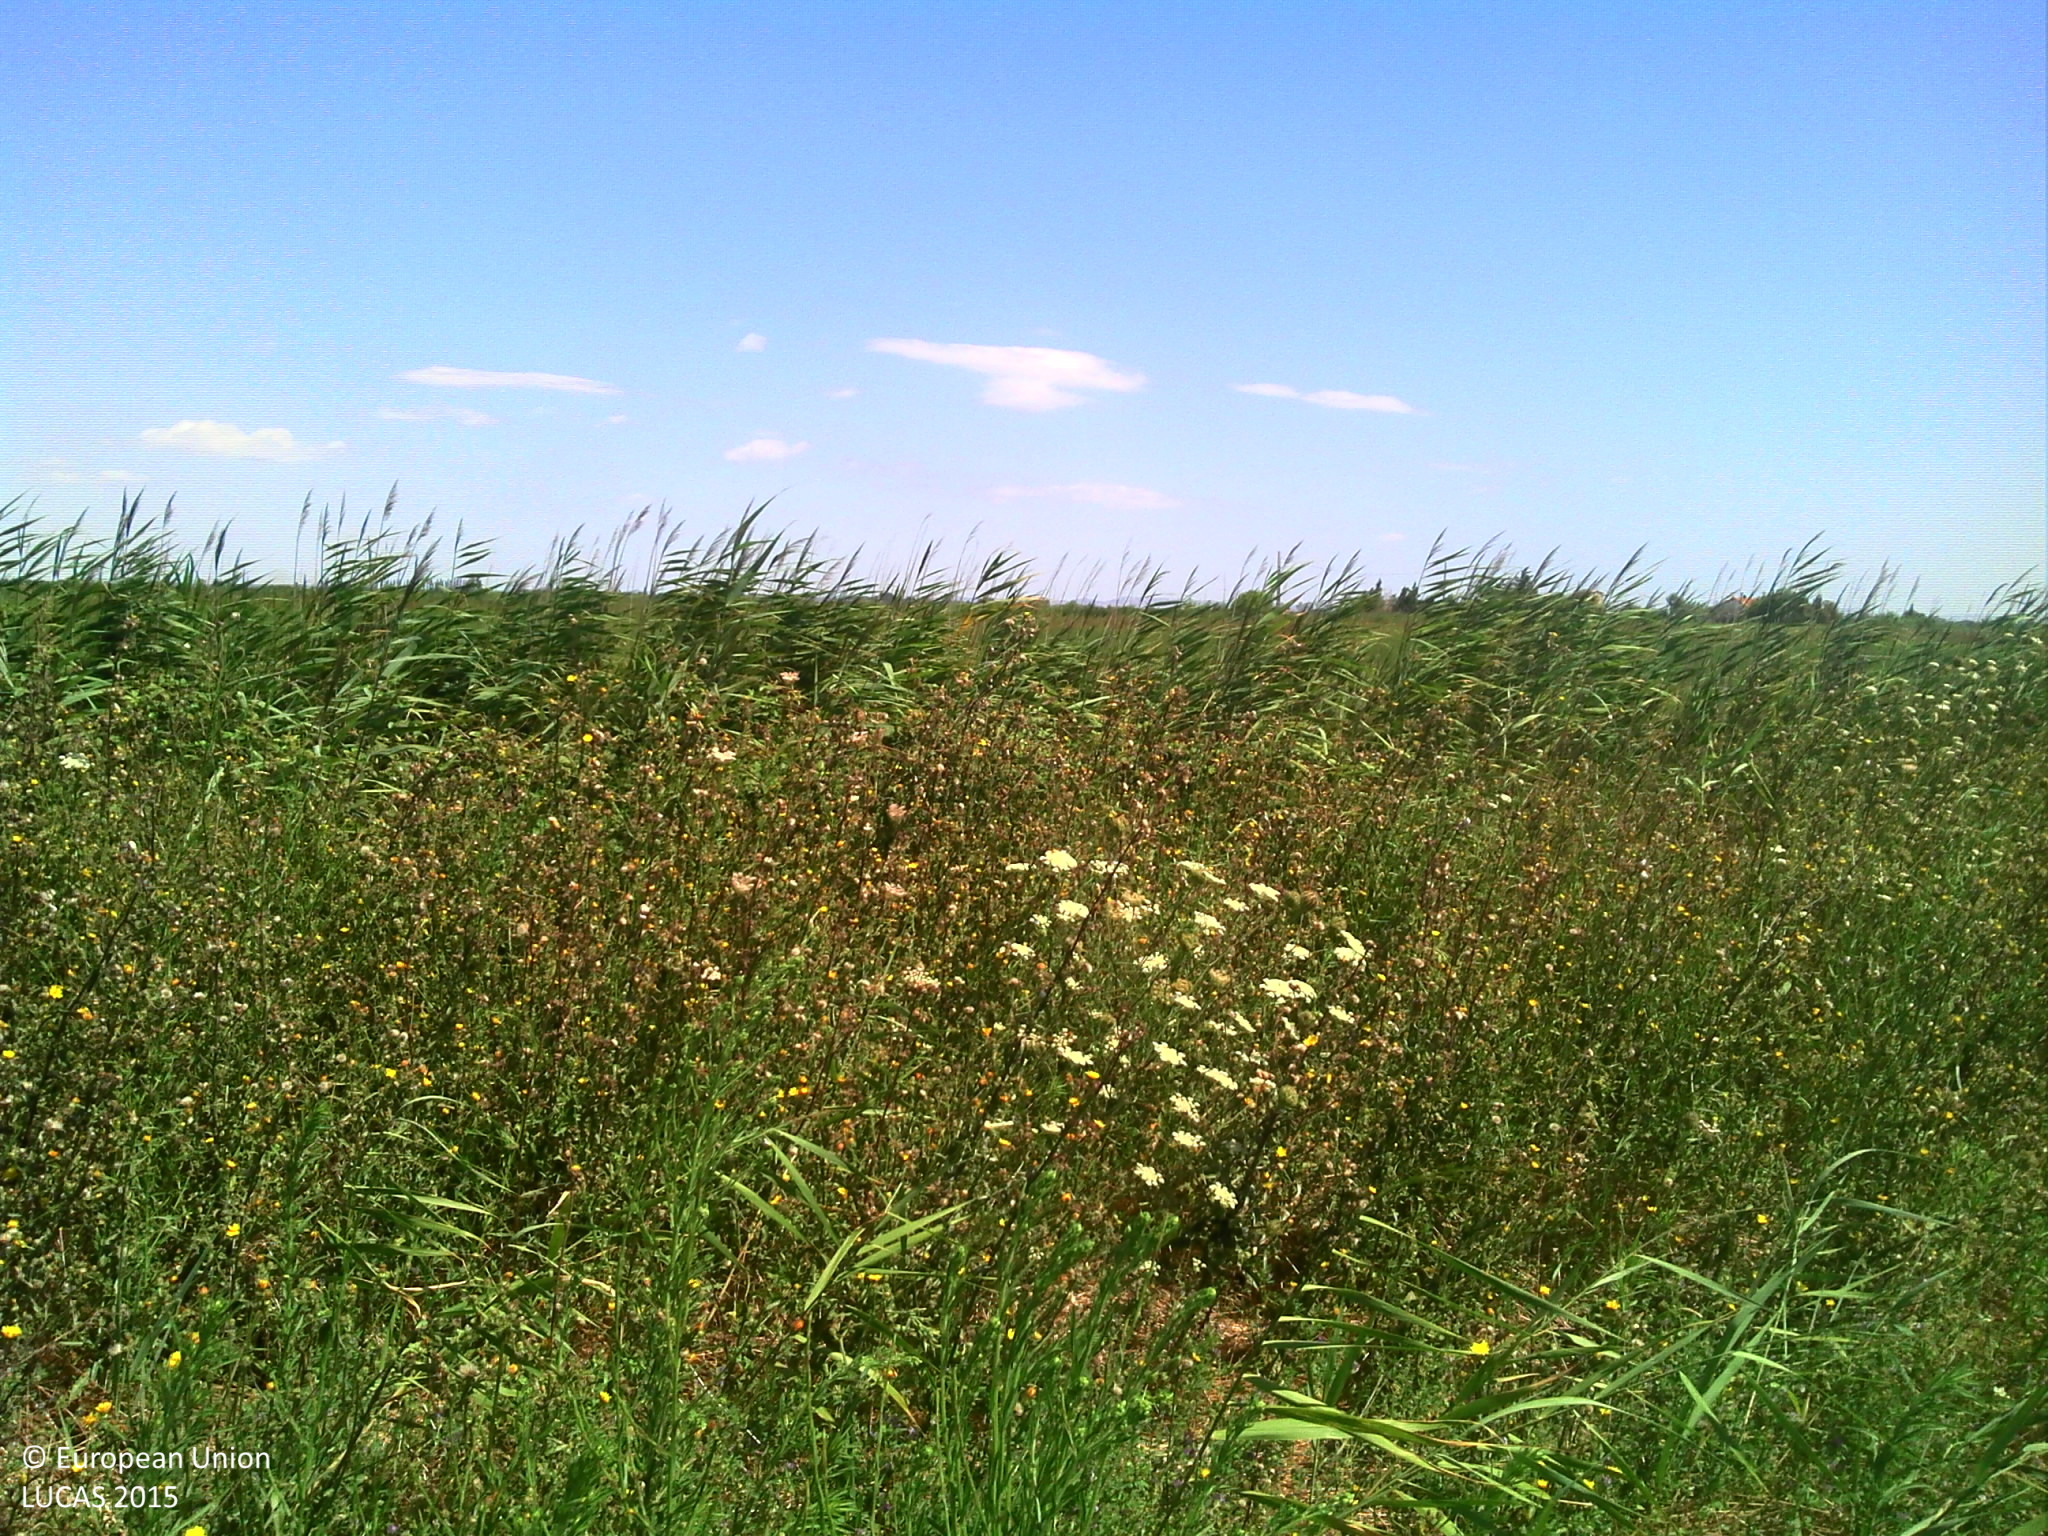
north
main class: Grassland
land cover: Grassland without tree/shrub cover
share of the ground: > 75 %
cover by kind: herbaceous plants 100 %
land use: Agriculture (excluding fallow land and kitchen gardens)
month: July
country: FR
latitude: 43.4743
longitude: 4.7067
